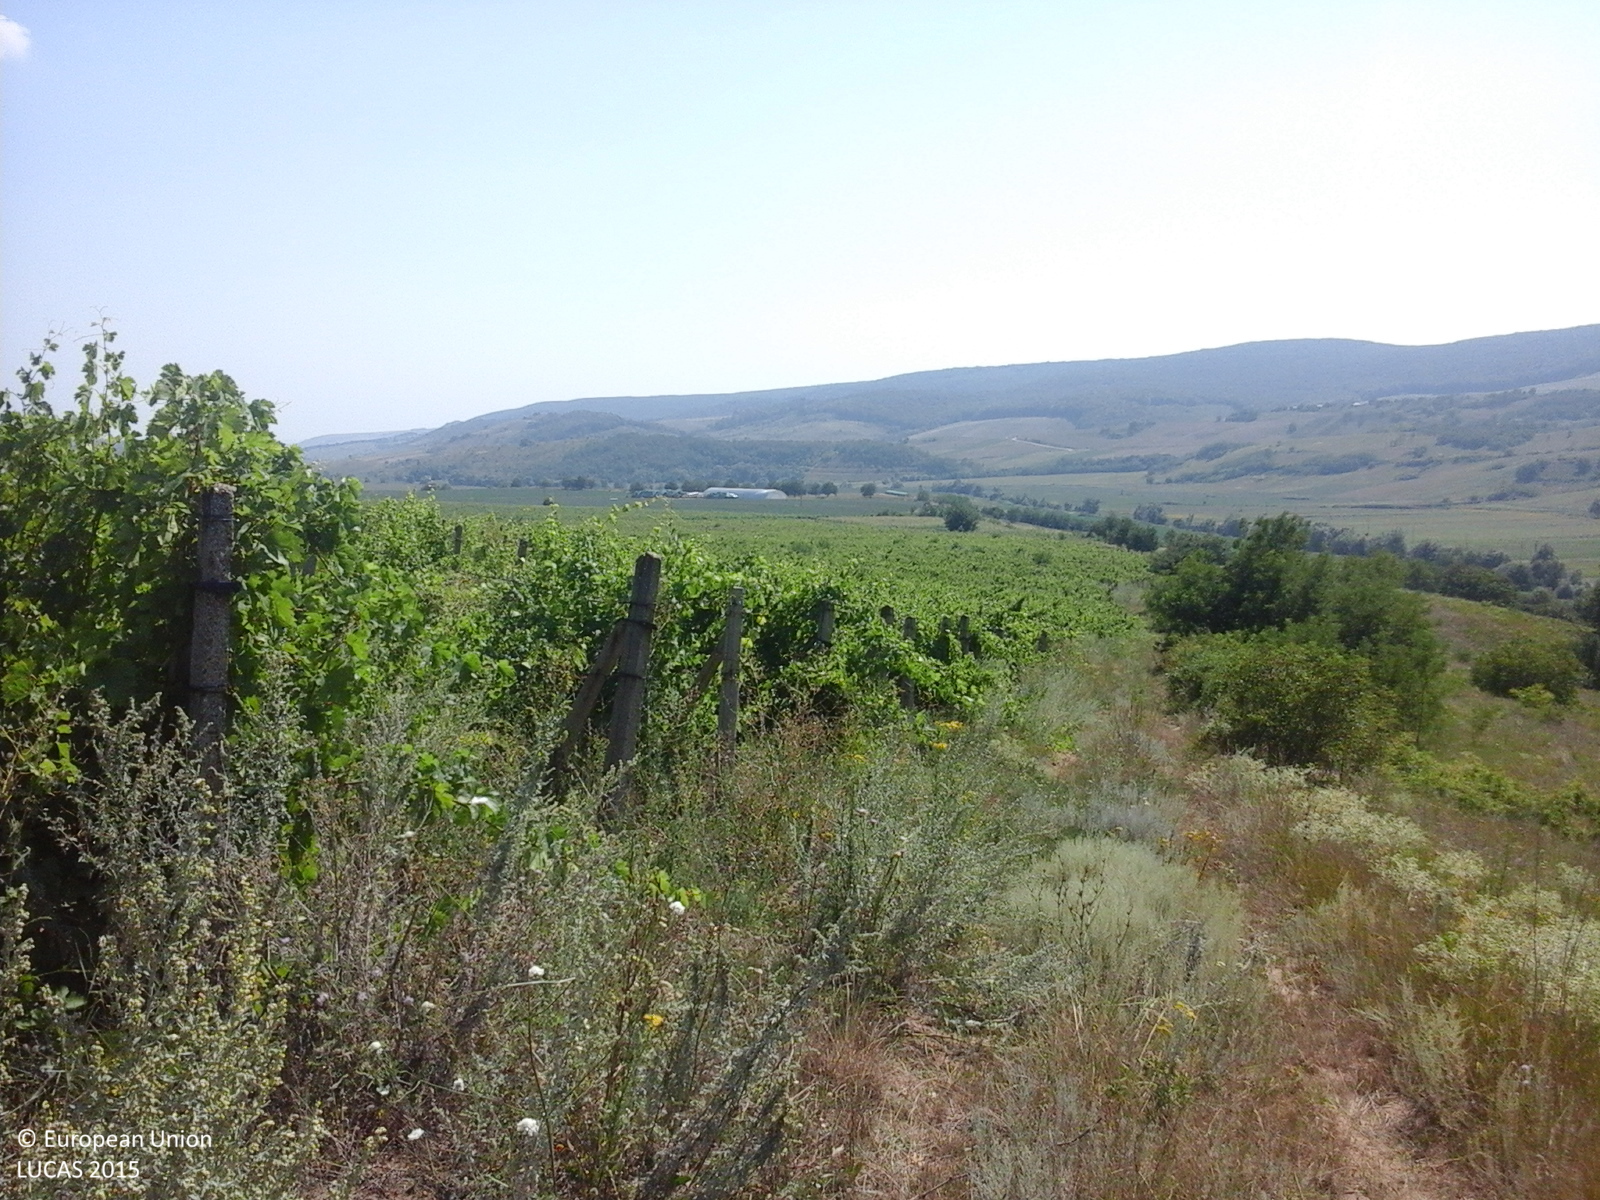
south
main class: Cropland
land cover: Vineyards
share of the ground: > 75 %
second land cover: Spontaneously vegetated surfaces
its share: 10 - 25 %
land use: Agriculture (excluding fallow land and kitchen gardens)
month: July
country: RO
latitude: 46.3849
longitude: 27.2800
